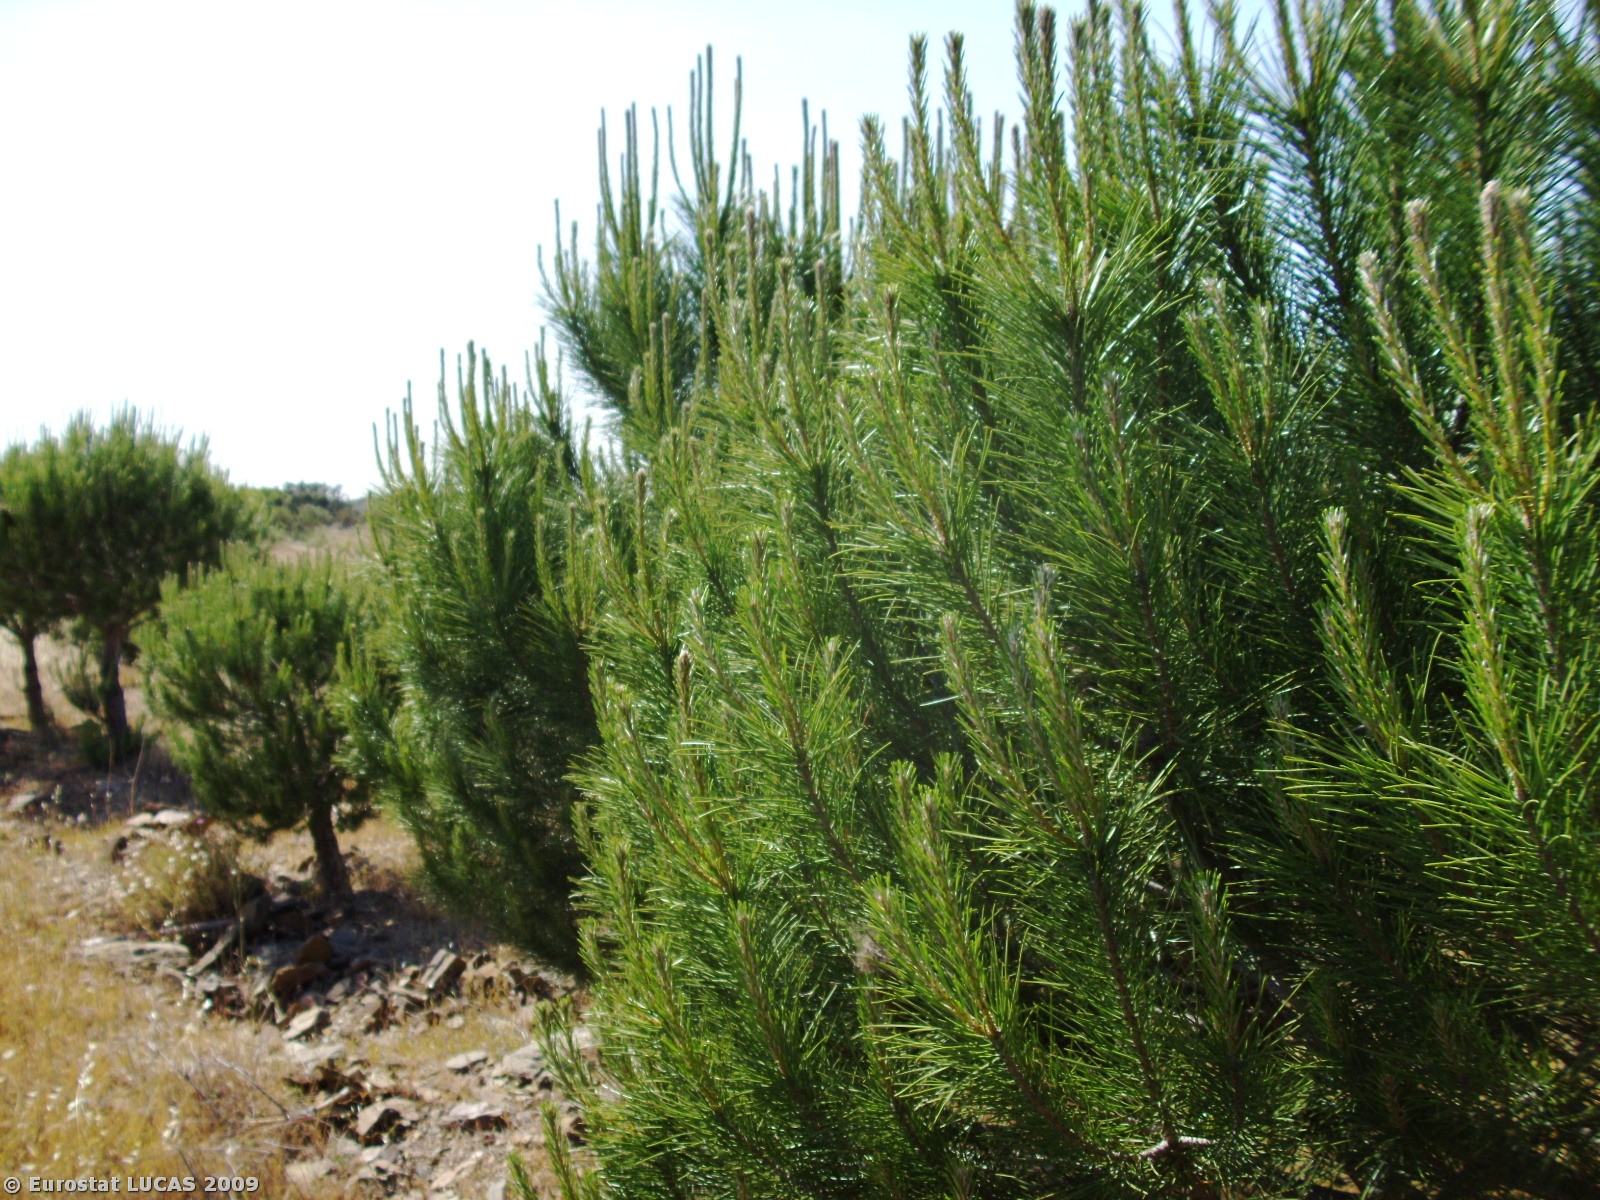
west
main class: Woodland
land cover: Coniferous woodland
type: coniferous forest of the mediterranean region
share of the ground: 10 - 25 %
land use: Forestry
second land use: Unused
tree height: > 5 m
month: May
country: PT
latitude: 37.4439
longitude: -7.4938
